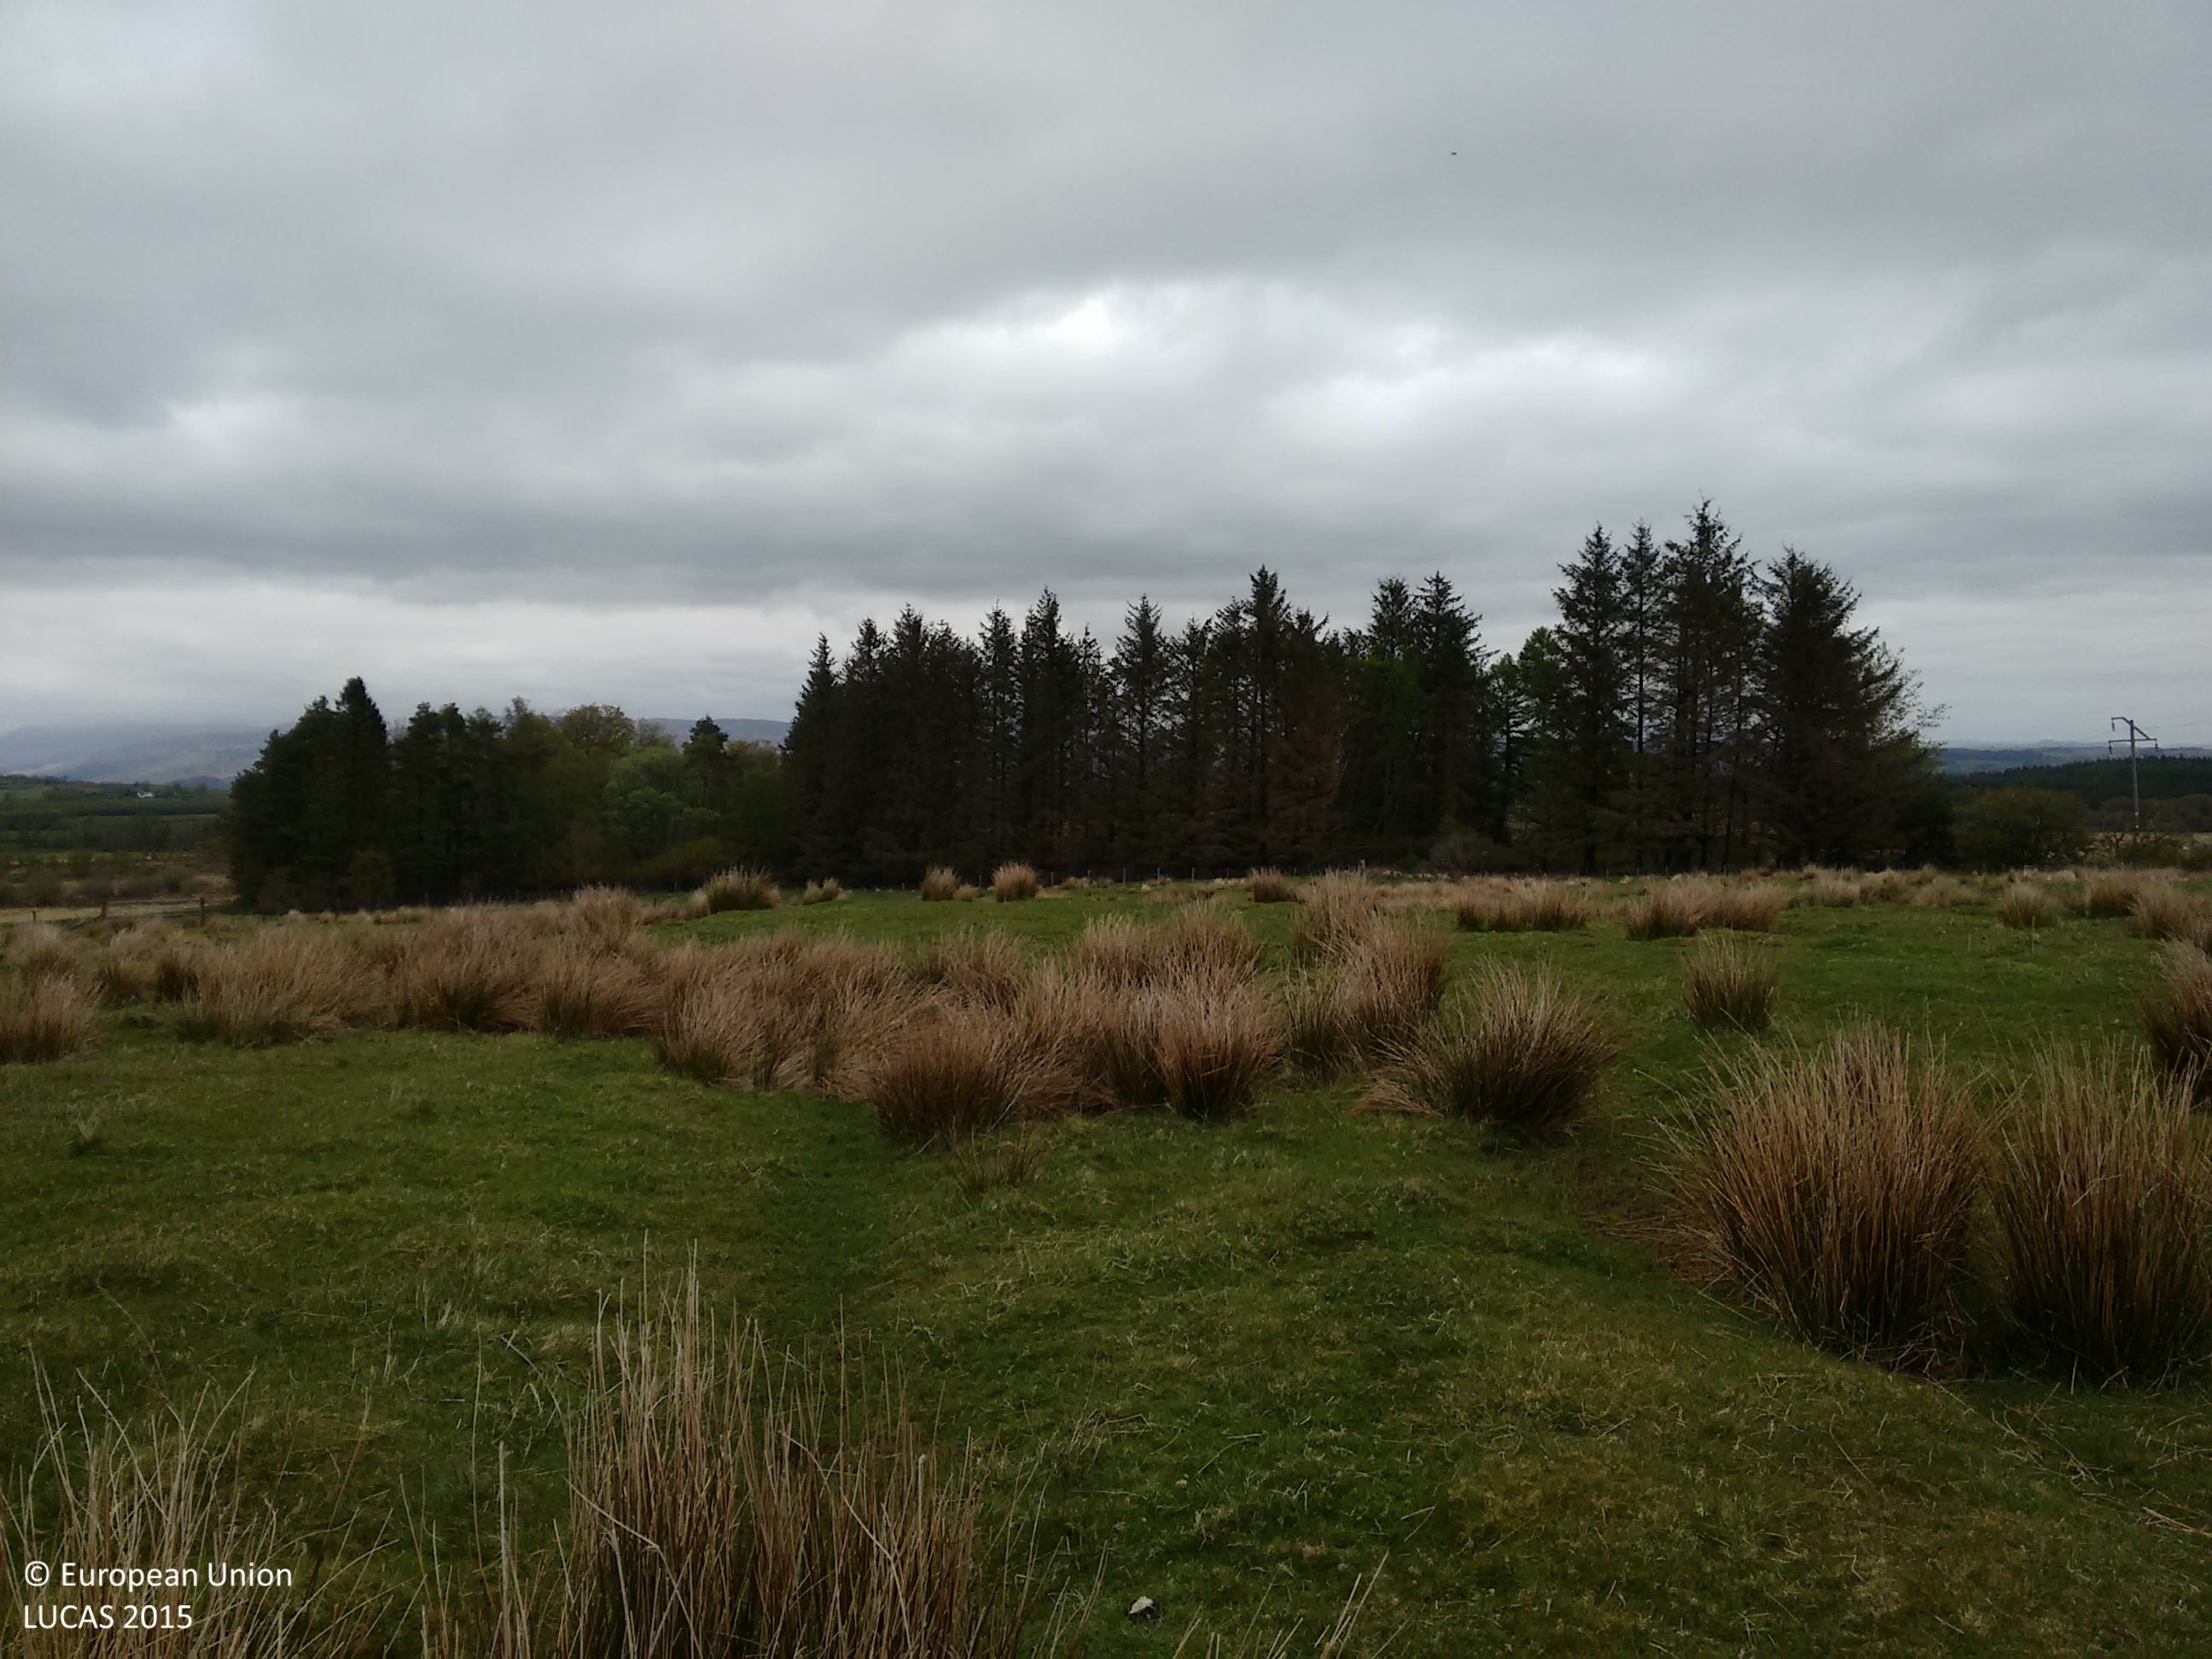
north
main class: Grassland
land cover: Grassland without tree/shrub cover
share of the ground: > 75 %
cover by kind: herbaceous plants 95 %, lichens and mosses 5 %
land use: Agriculture (excluding fallow land and kitchen gardens)
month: May
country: GB
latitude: 56.0183
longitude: -4.4878
